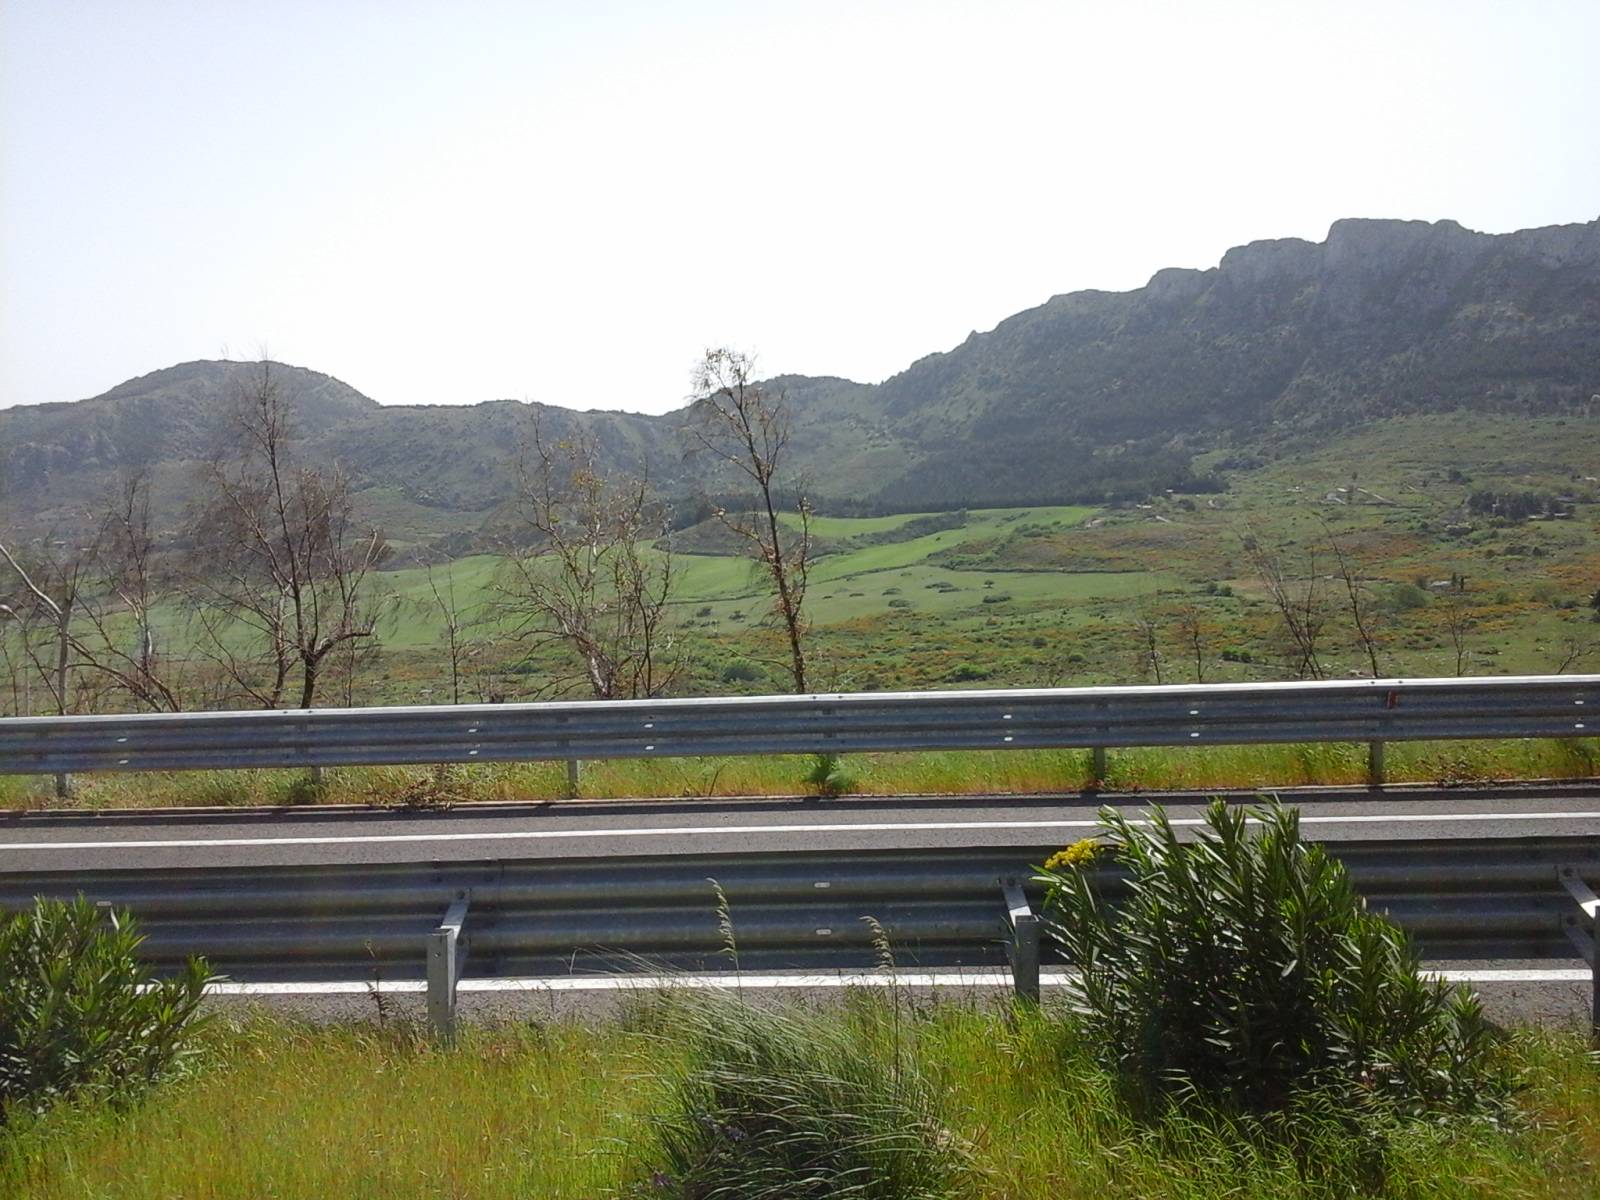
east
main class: Woodland
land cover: Broadleaved woodland
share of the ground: 25 - 50 %
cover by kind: shrubs 65 %, broadleaved forest trees 35 %
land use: Agriculture (excluding fallow land and kitchen gardens)
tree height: < 5 m
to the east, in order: Broadleaved woodland; Artificial constructions in urban areas; Grassland without tree/shrub cover
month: May
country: IT
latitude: 38.0191
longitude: 13.2461
